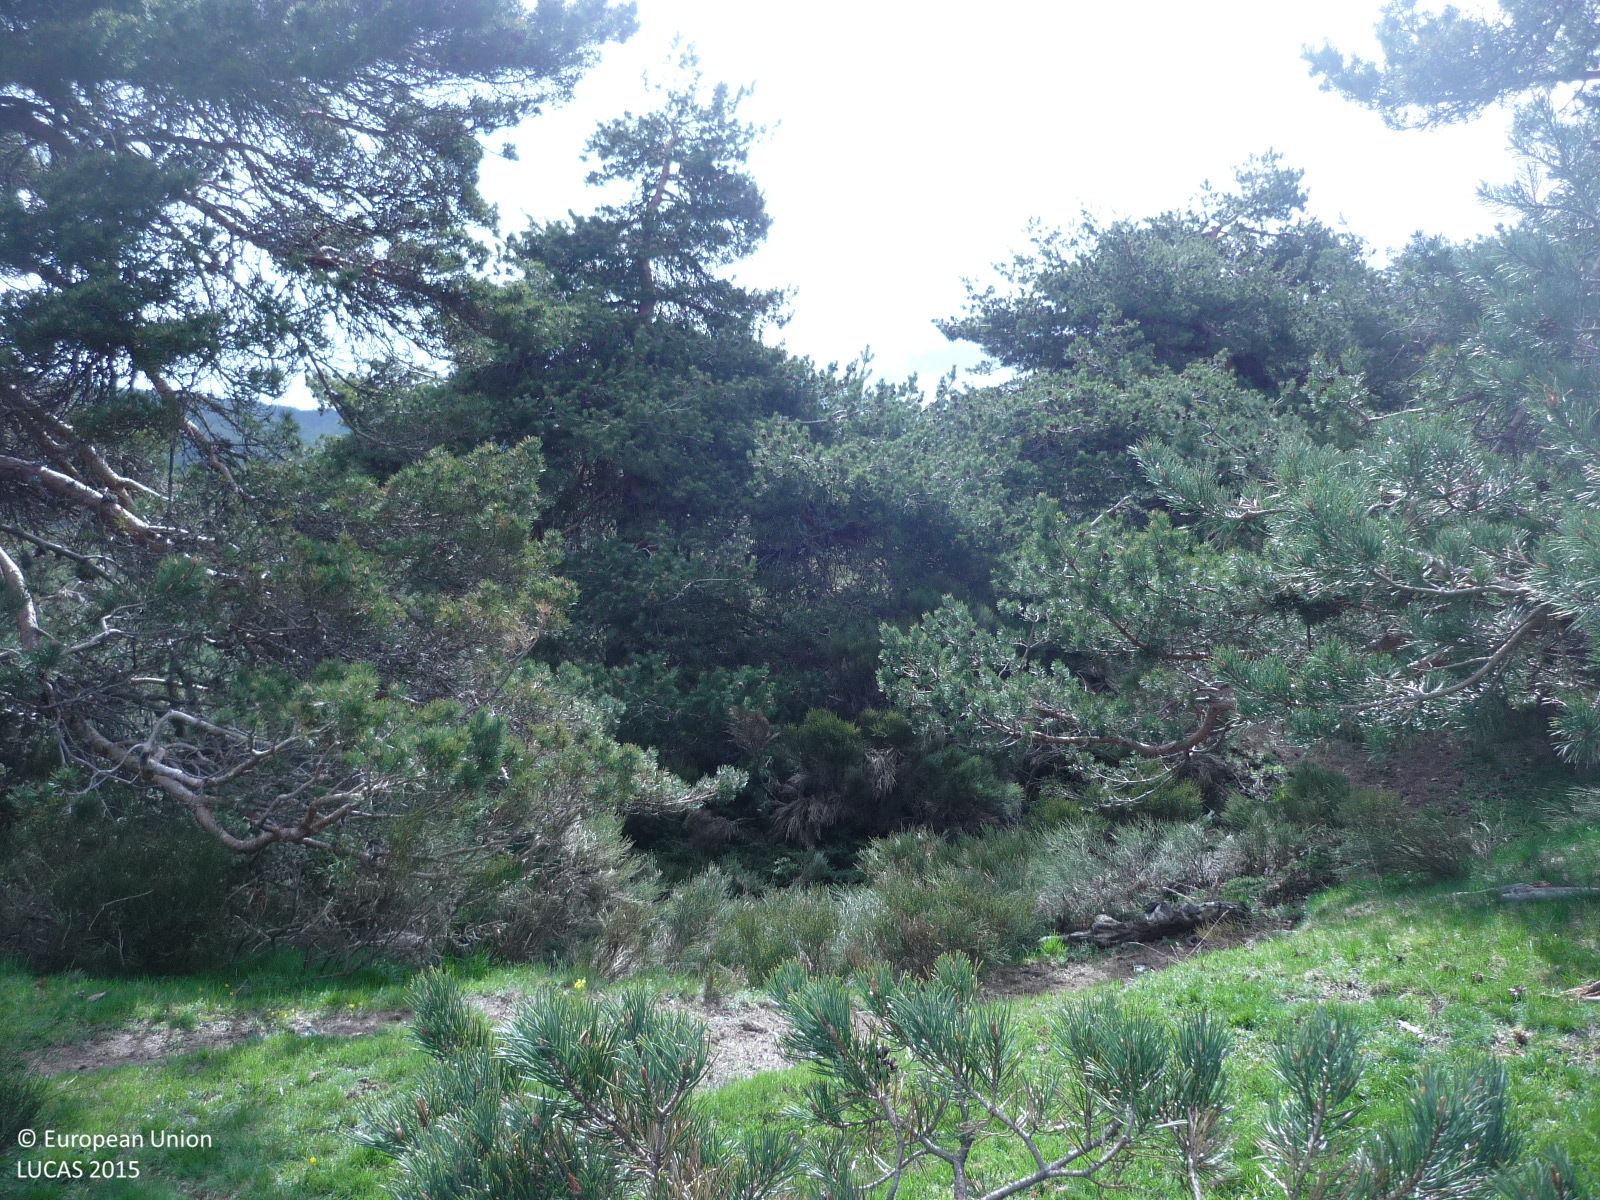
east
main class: Woodland
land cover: Pine dominated coniferous woodland
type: coniferous forest of the mediterranean region
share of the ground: 50 - 75 %
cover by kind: coniferous forest trees 60 %, herbaceous plants 30 %, shrubs 10 %
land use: Forestry
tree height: > 5 m
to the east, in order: Pine dominated coniferous woodland; Rocks and stones
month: May
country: ES
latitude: 41.0780
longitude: -3.6980
